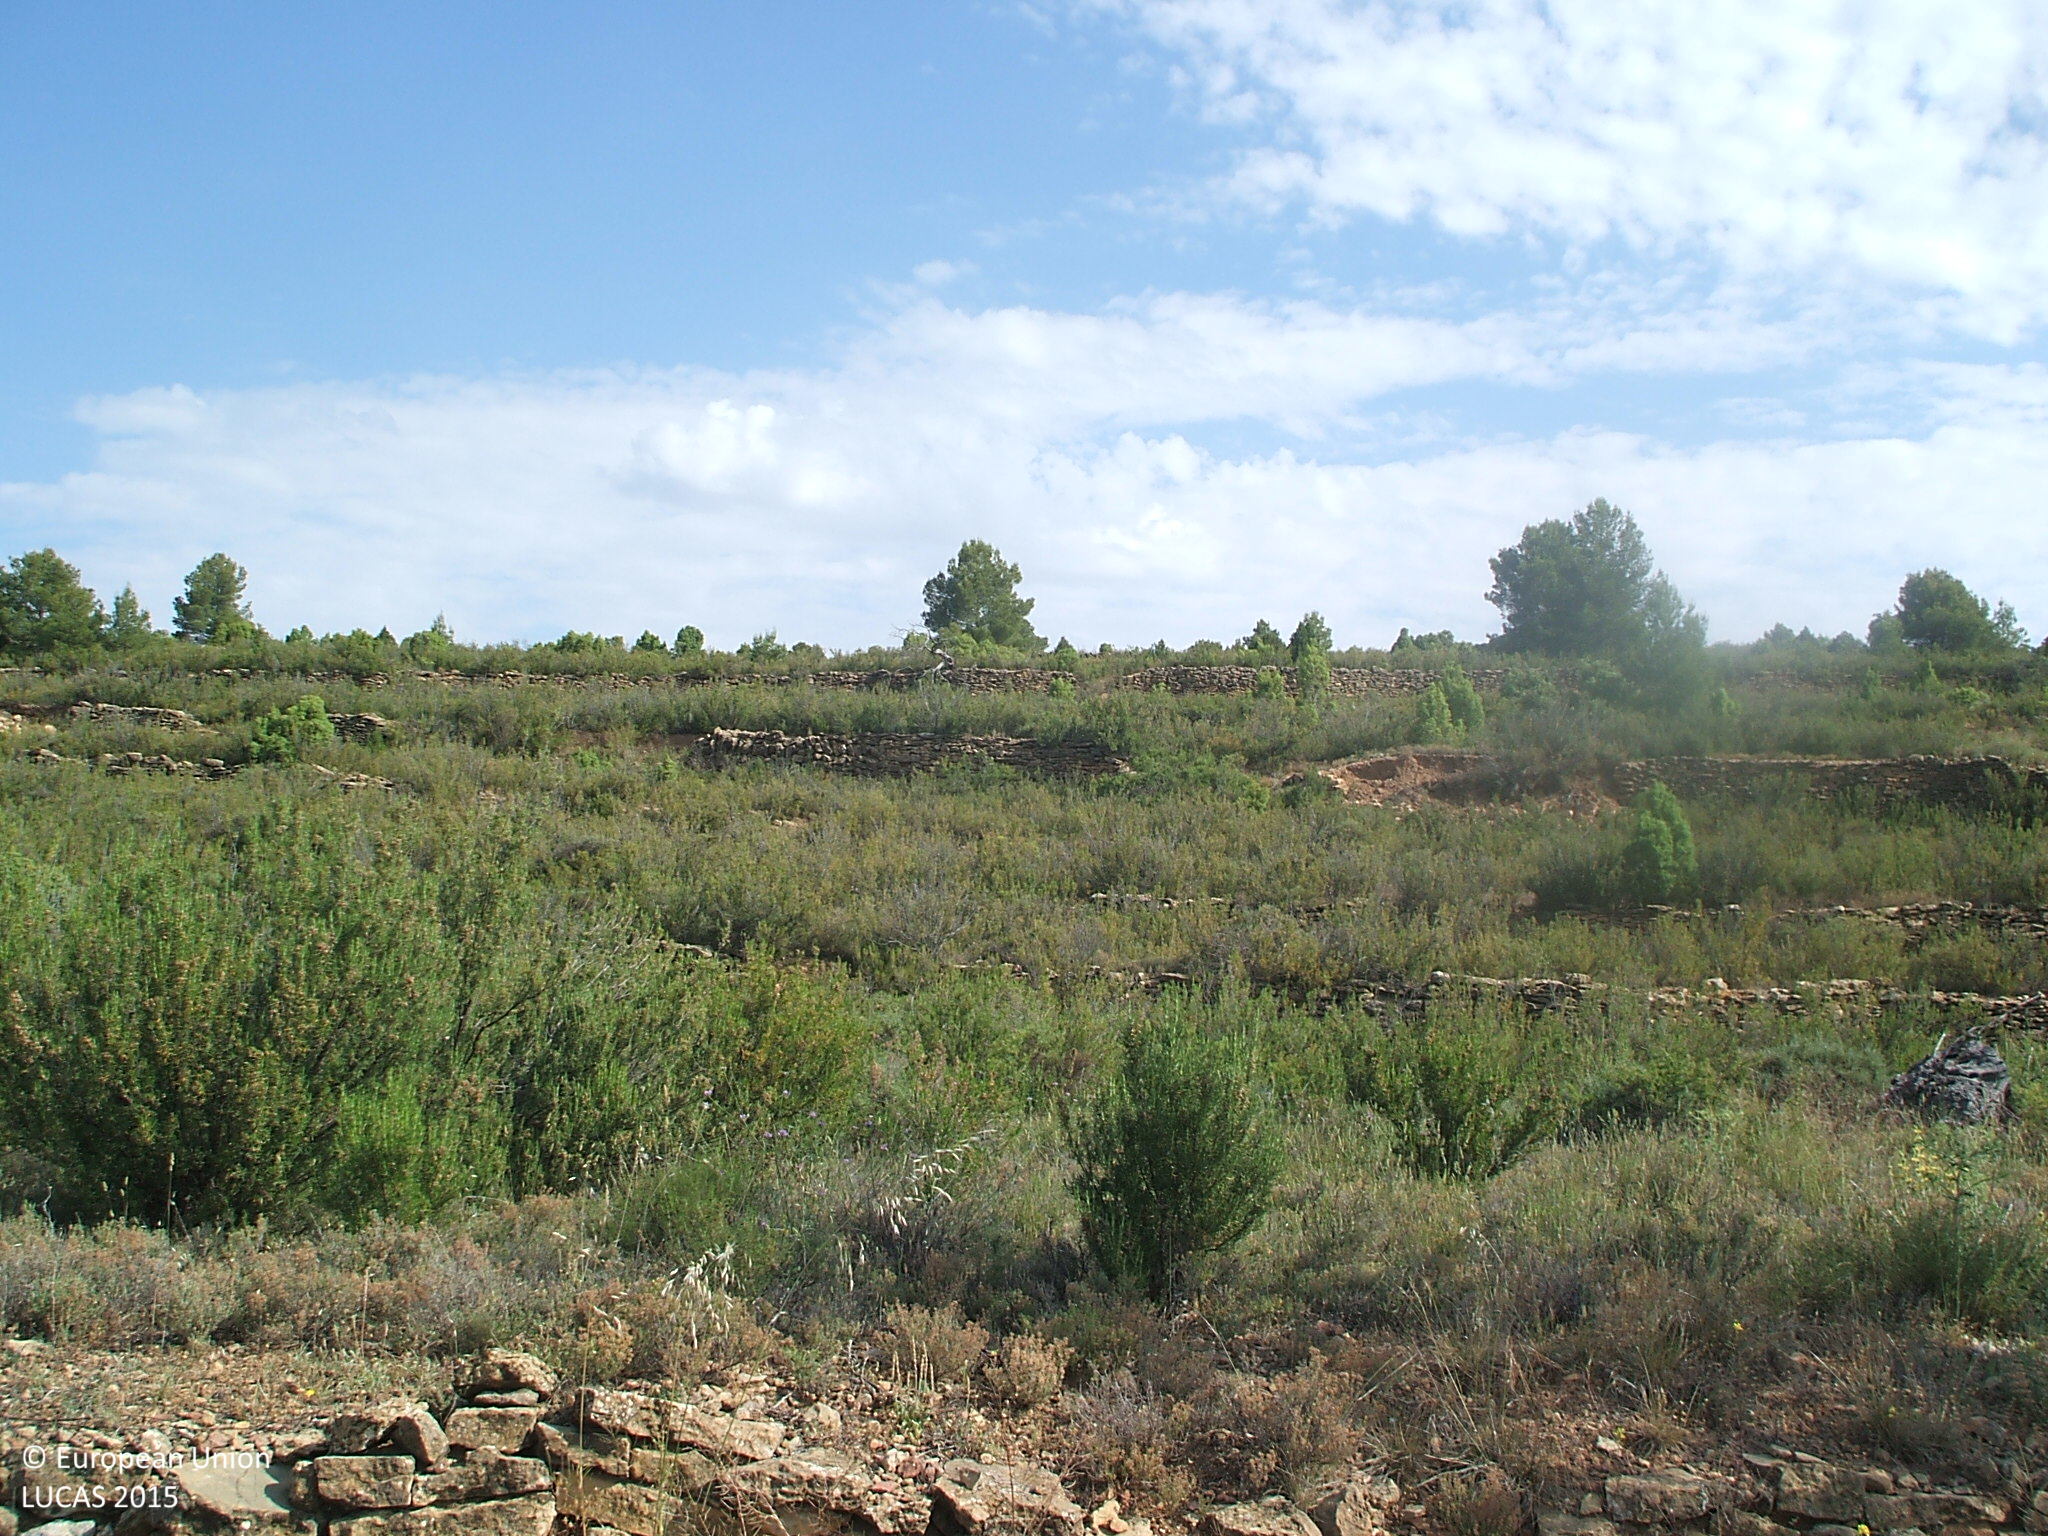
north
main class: Cropland
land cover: Nuts trees
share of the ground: 10 - 25 %
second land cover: Grassland without tree/shrub cover
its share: > 75 %
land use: Agriculture (excluding fallow land and kitchen gardens)
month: June
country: ES
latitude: 40.7848
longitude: -0.2599
